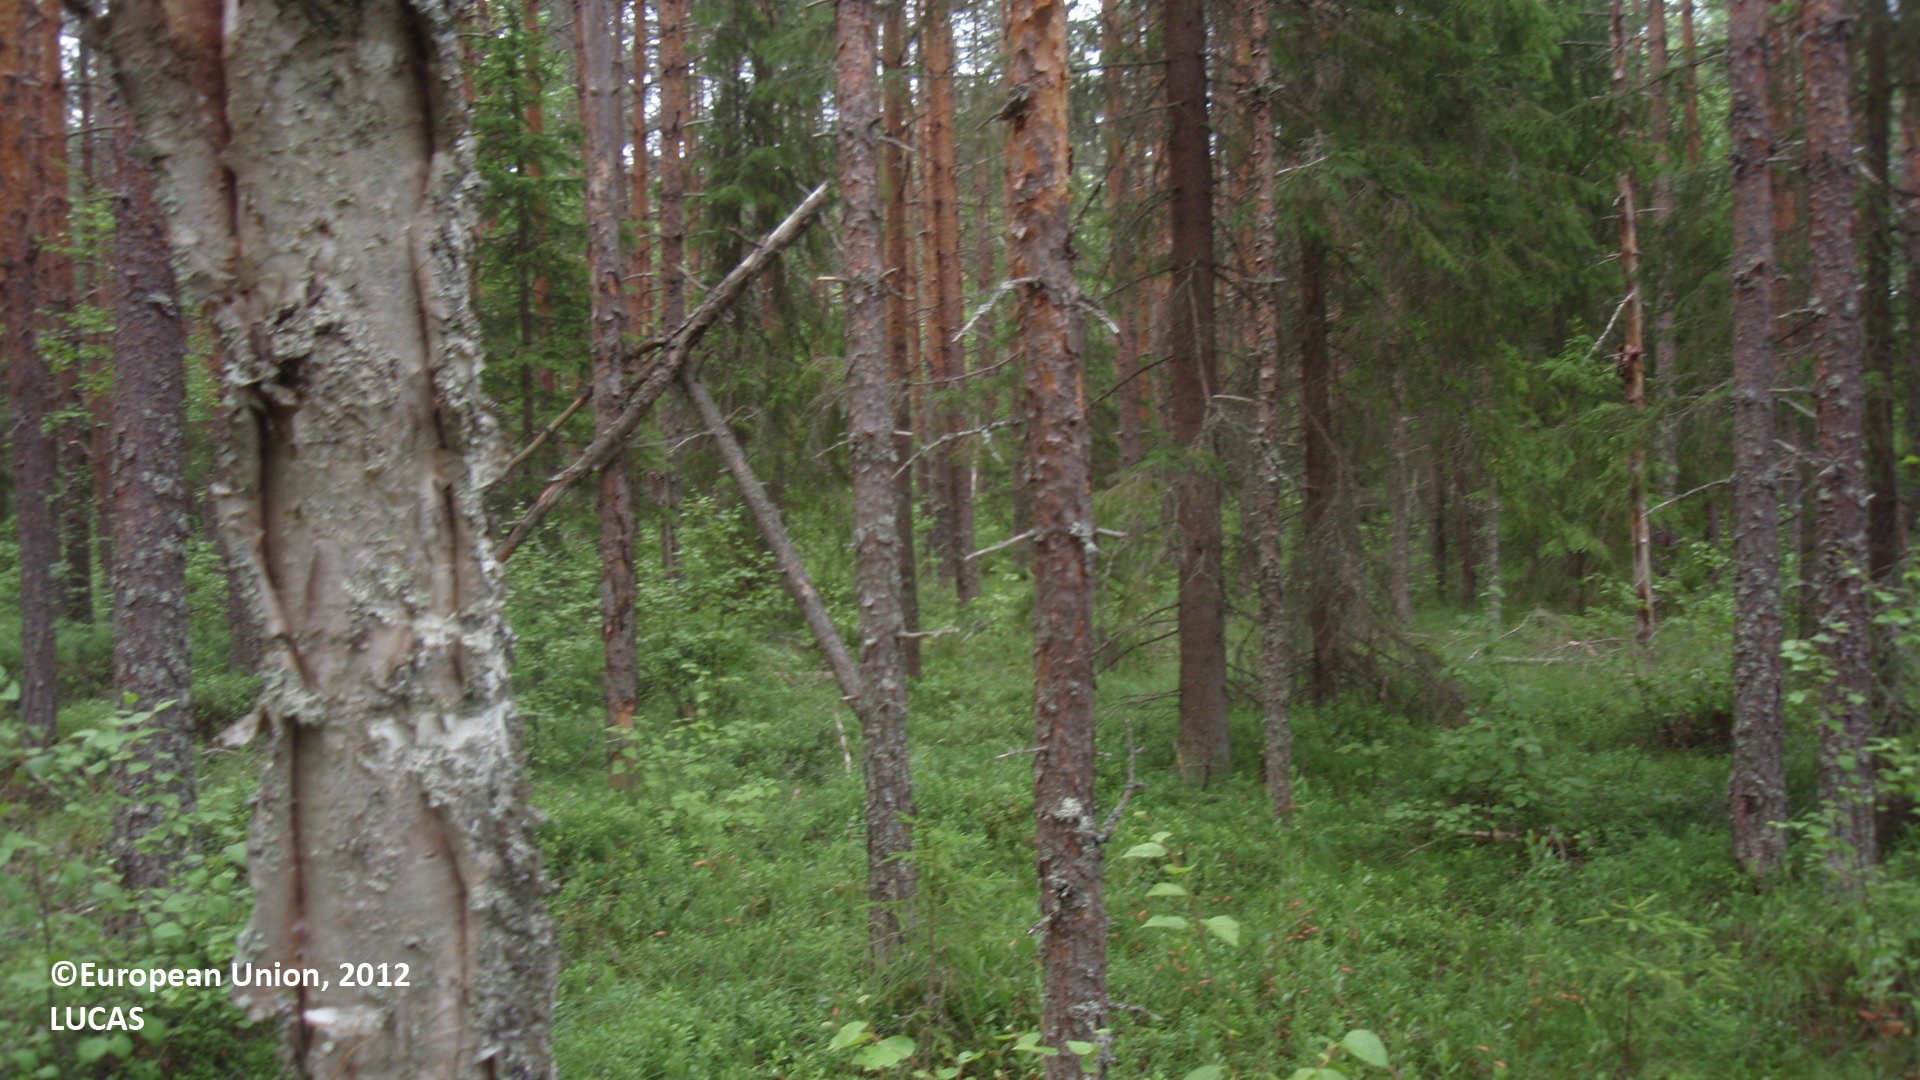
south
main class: Woodland
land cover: Pine dominated coniferous woodland
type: boreal forest
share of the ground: 25 - 50 %
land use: Forestry
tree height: > 5 m
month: July
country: FI
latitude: 61.5366
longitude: 28.8256
